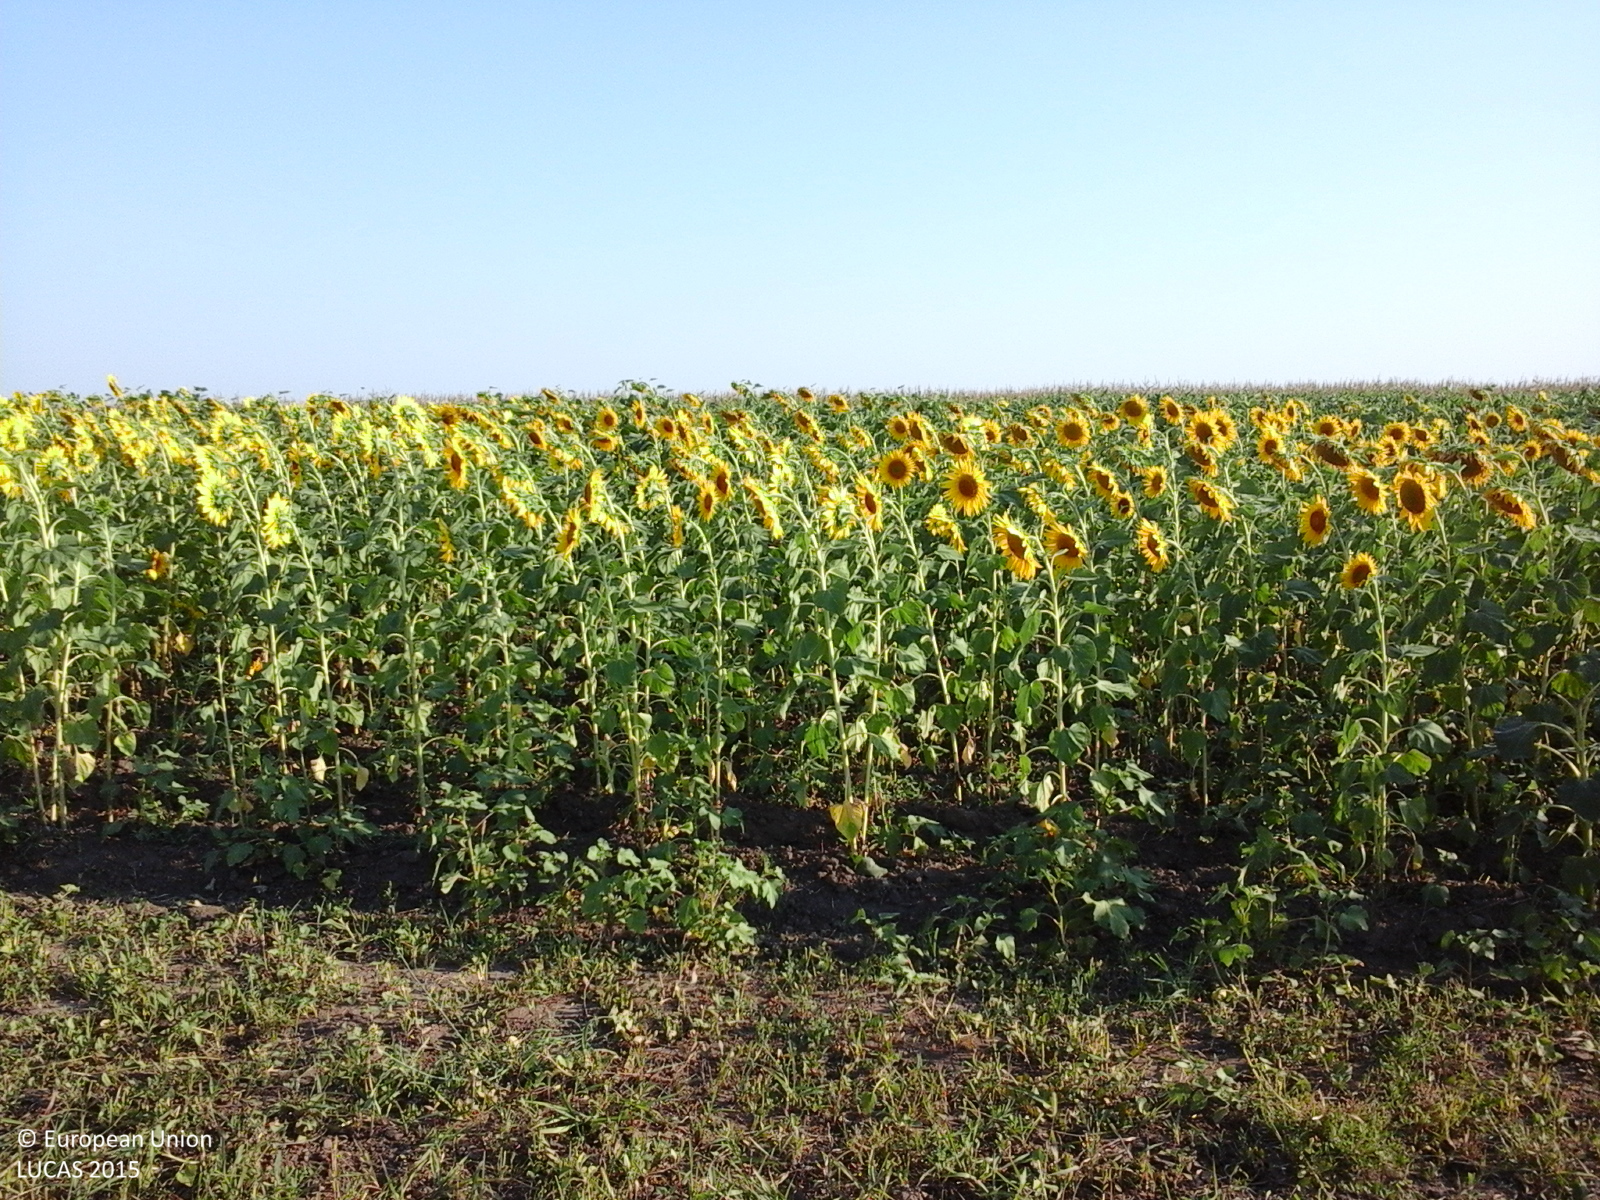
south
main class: Cropland
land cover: Lucerne
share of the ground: > 75 %
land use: Agriculture (excluding fallow land and kitchen gardens)
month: July
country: RO
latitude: 44.8120
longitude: 27.2212
